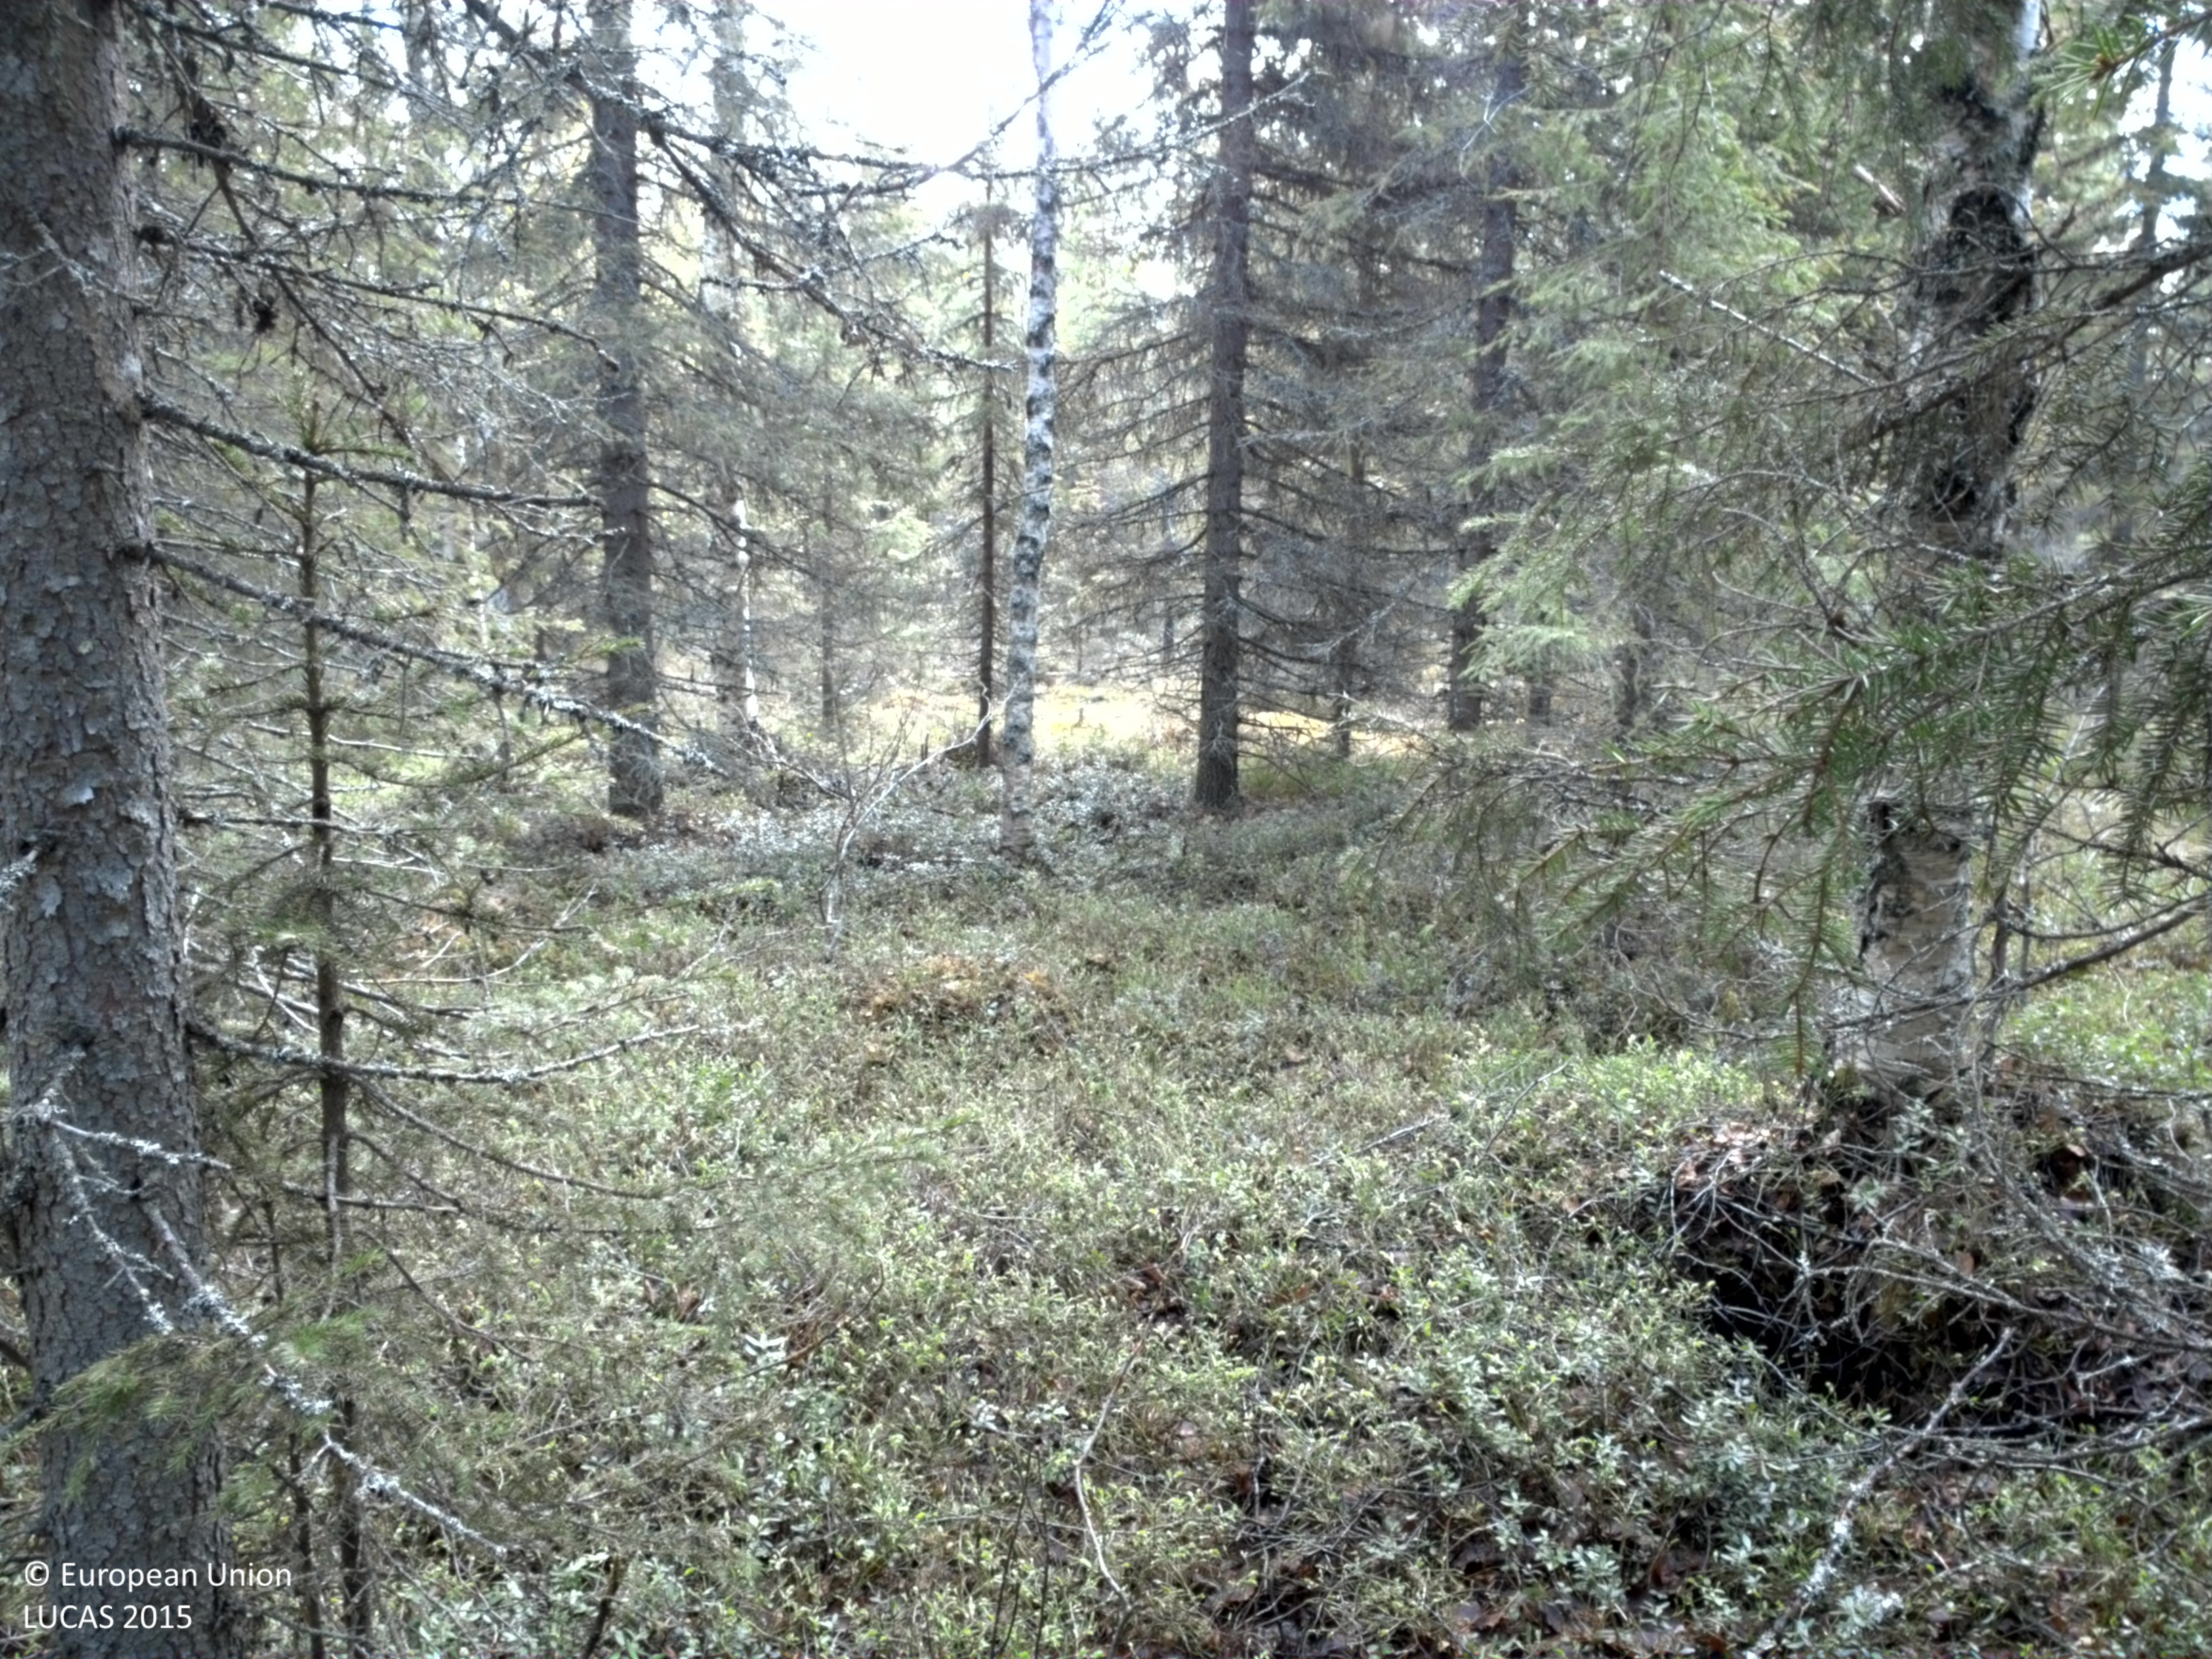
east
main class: Woodland
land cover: Other coniferous woodland
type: boreal forest
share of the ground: > 75 %
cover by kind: coniferous forest trees 65 %, shrubs 25 %, broadleaved forest trees 10 %
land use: Forestry
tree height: > 5 m
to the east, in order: Other coniferous woodland; Pine dominated mixed woodland; Ditches and canals; Paved roads, cycling and walking lanes; Spruce dominated mixed woodland
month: June
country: SE
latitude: 66.4170
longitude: 23.4465
